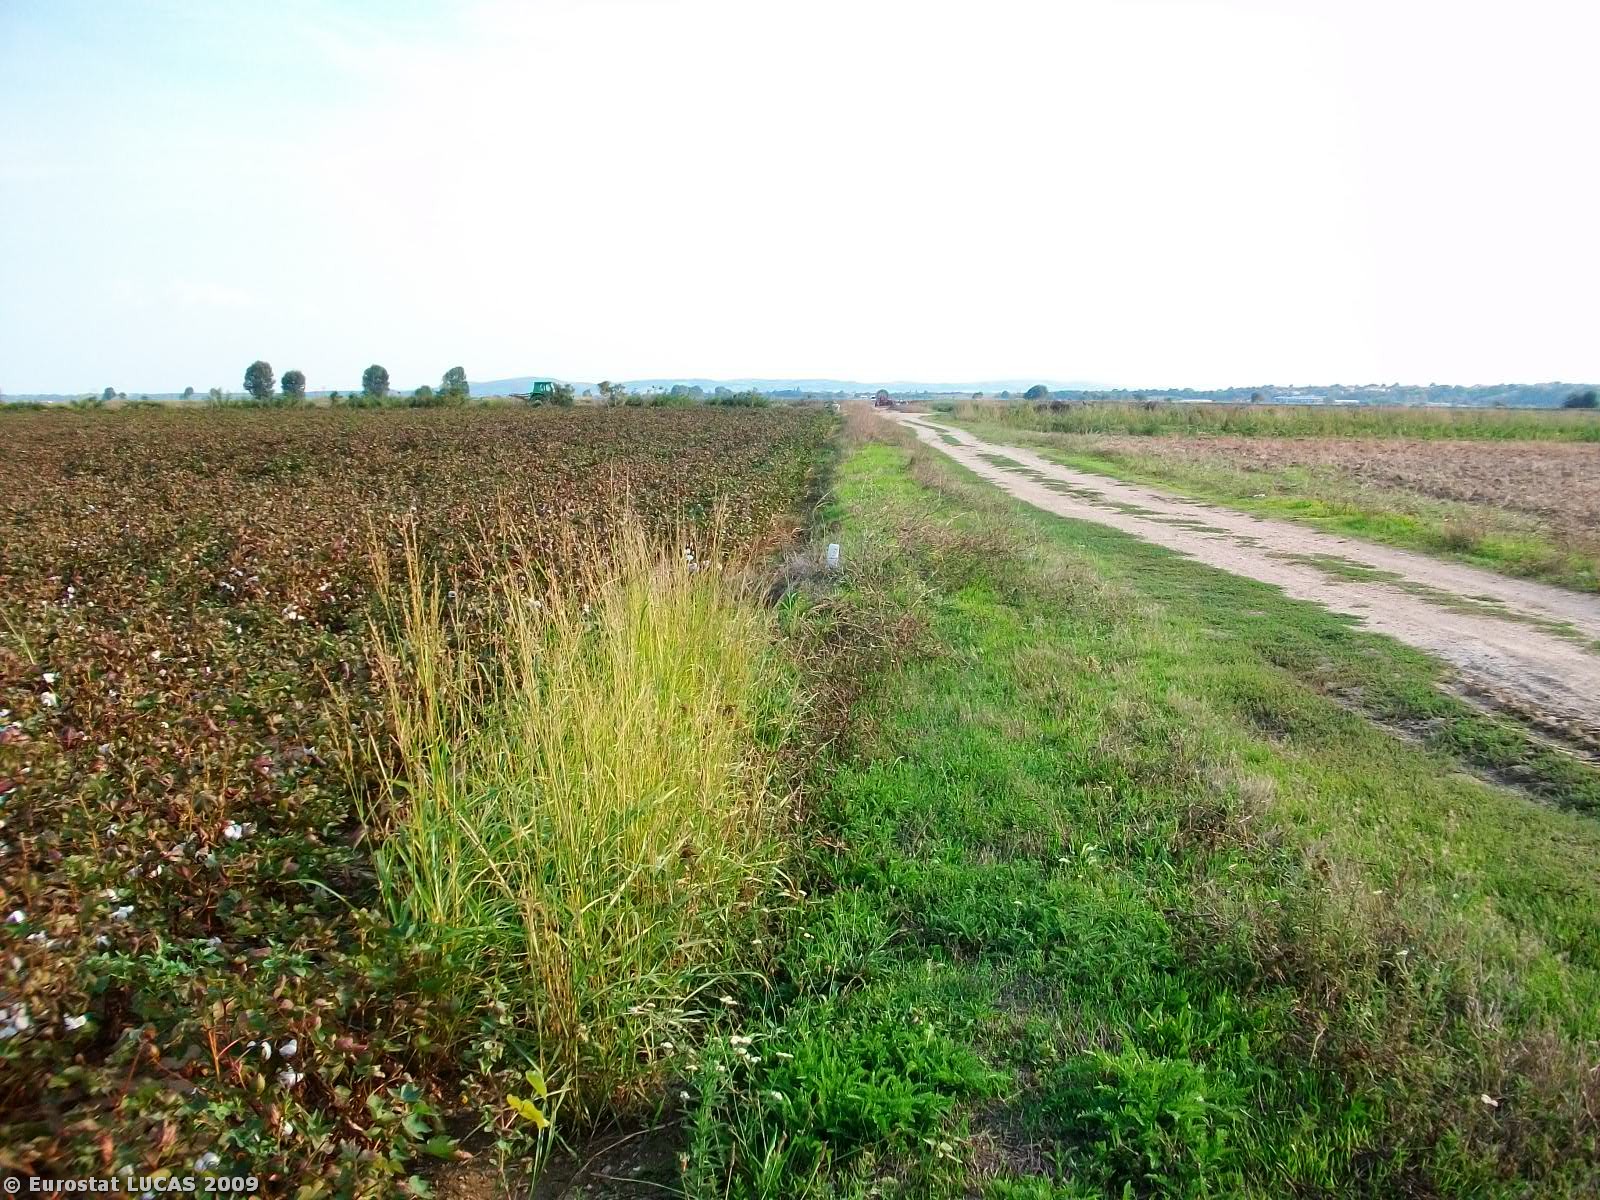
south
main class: Cropland
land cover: Cotton
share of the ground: > 75 %
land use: Agriculture (excluding fallow land and kitchen gardens)
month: September
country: GR
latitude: 41.0461
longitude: 26.3070
